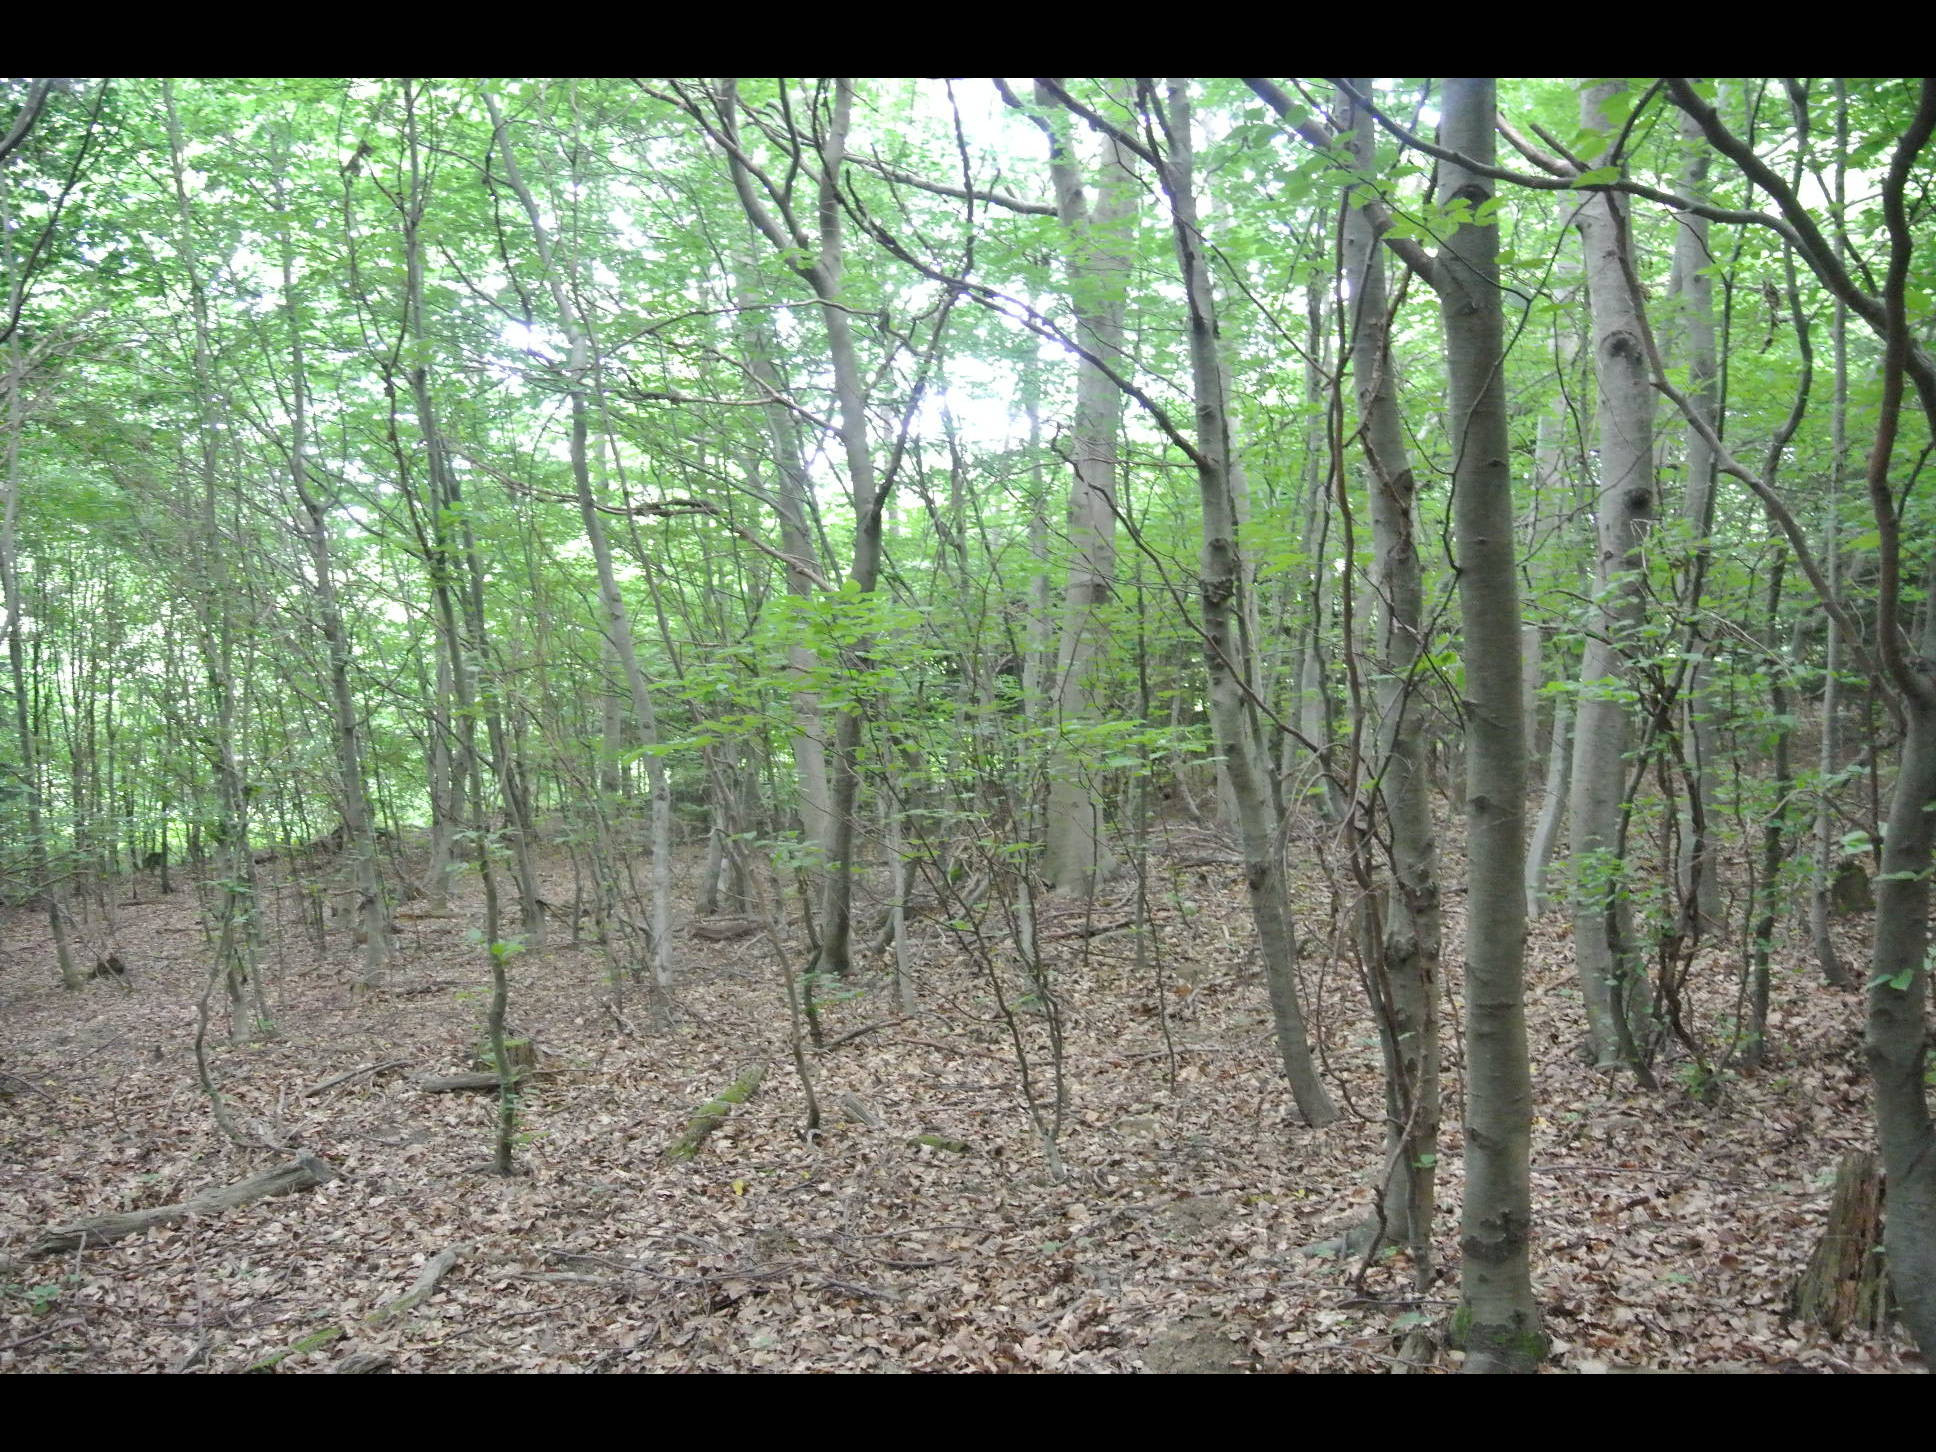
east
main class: Woodland
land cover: Spruce dominated mixed woodland
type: alpine coniferous forest
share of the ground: > 75 %
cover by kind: broadleaved forest trees 75 %, coniferous forest trees 25 %
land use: Forestry
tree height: > 5 m
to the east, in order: Spruce dominated mixed woodland; Broadleaved woodland; Spontaneously vegetated surfaces; Broadleaved woodland; Tracks; Other mixed woodland
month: June
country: AT
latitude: 48.0512
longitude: 16.1618
